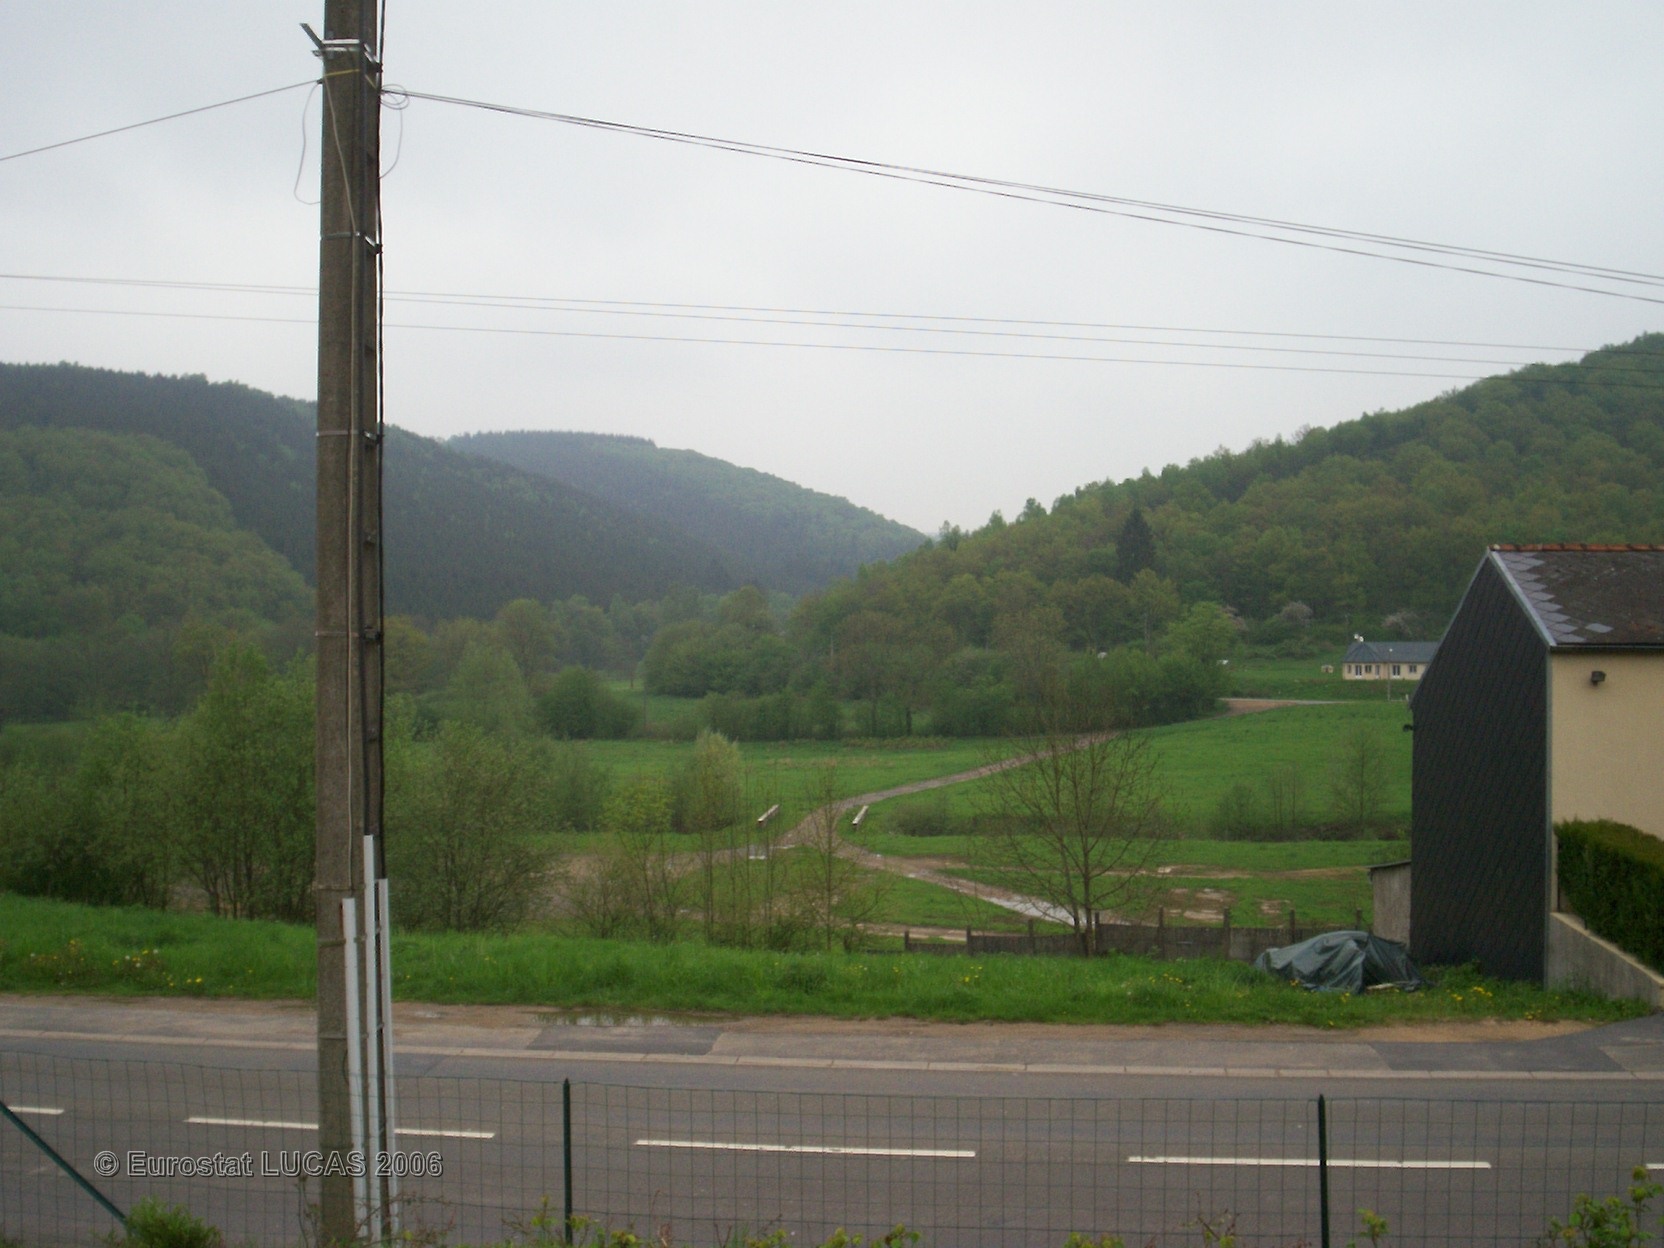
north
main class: Grassland
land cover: Grassland without tree/shrub cover
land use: Residential
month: May
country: FR
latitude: 49.8127
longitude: 4.7855
